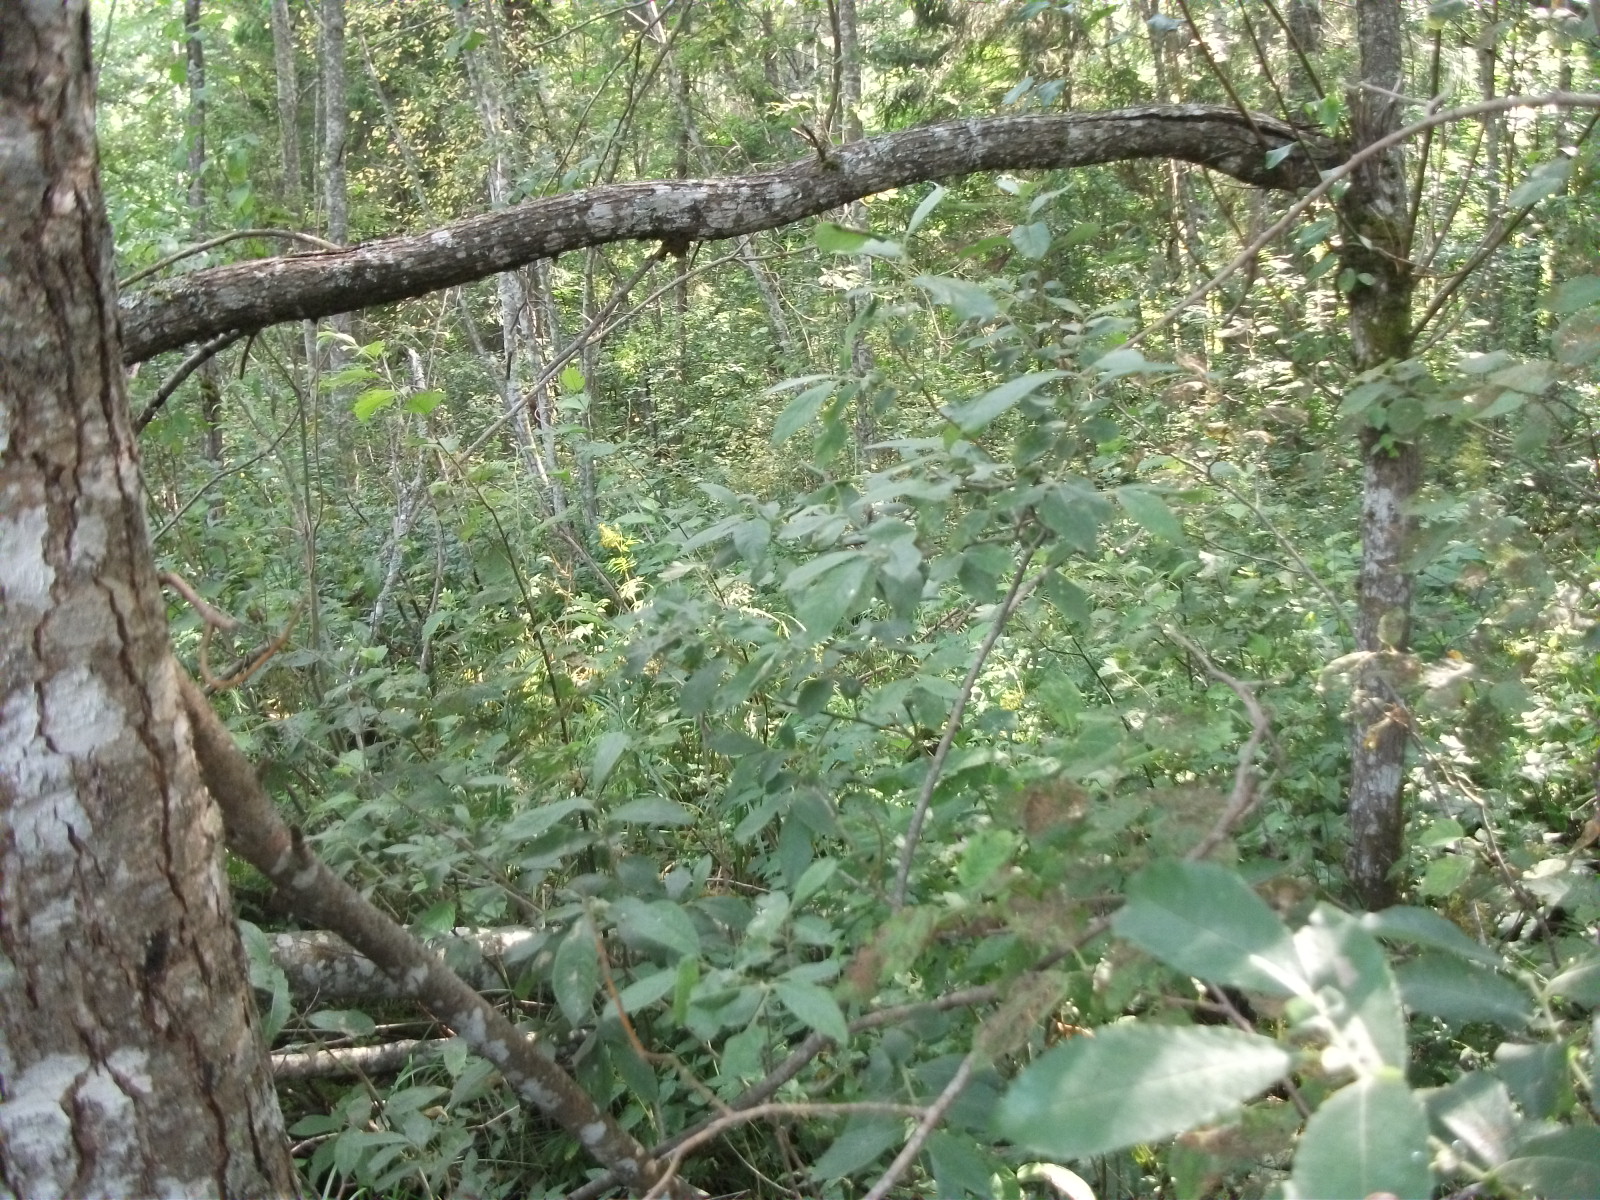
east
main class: Woodland
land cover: Broadleaved woodland
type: non-riverine alder, birch or aspen forest
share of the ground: > 75 %
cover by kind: broadleaved forest trees 90 %, shrubs 5 %, herbaceous plants 5 %
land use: Forestry
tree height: > 5 m
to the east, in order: Broadleaved woodland; Ditches and canals; Broadleaved woodland
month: August
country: LV
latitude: 56.9045
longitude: 26.4163
